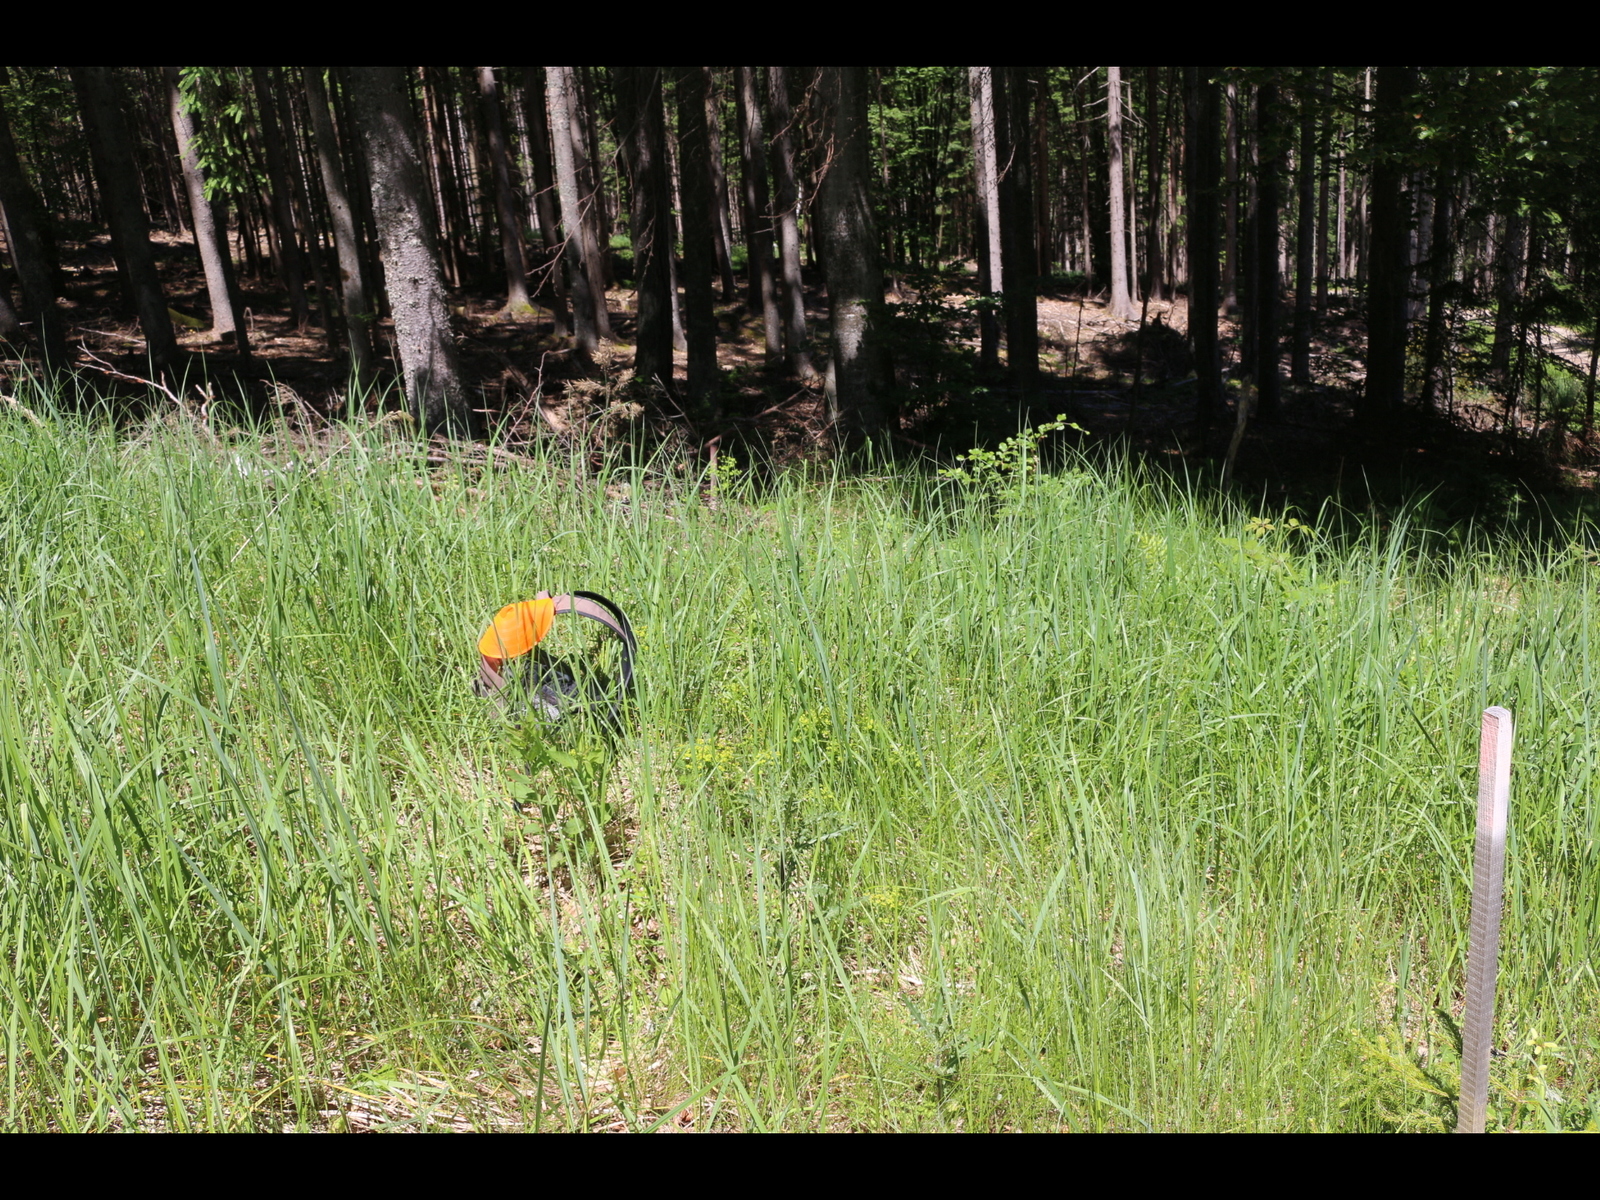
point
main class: Woodland
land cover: Spruce dominated mixed woodland
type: mountainous beech forest
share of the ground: > 75 %
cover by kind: coniferous forest trees 60 %, broadleaved forest trees 35 %, herbaceous plants 5 %
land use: Forestry
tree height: > 5 m
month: May
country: AT
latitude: 46.5279
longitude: 14.0255
